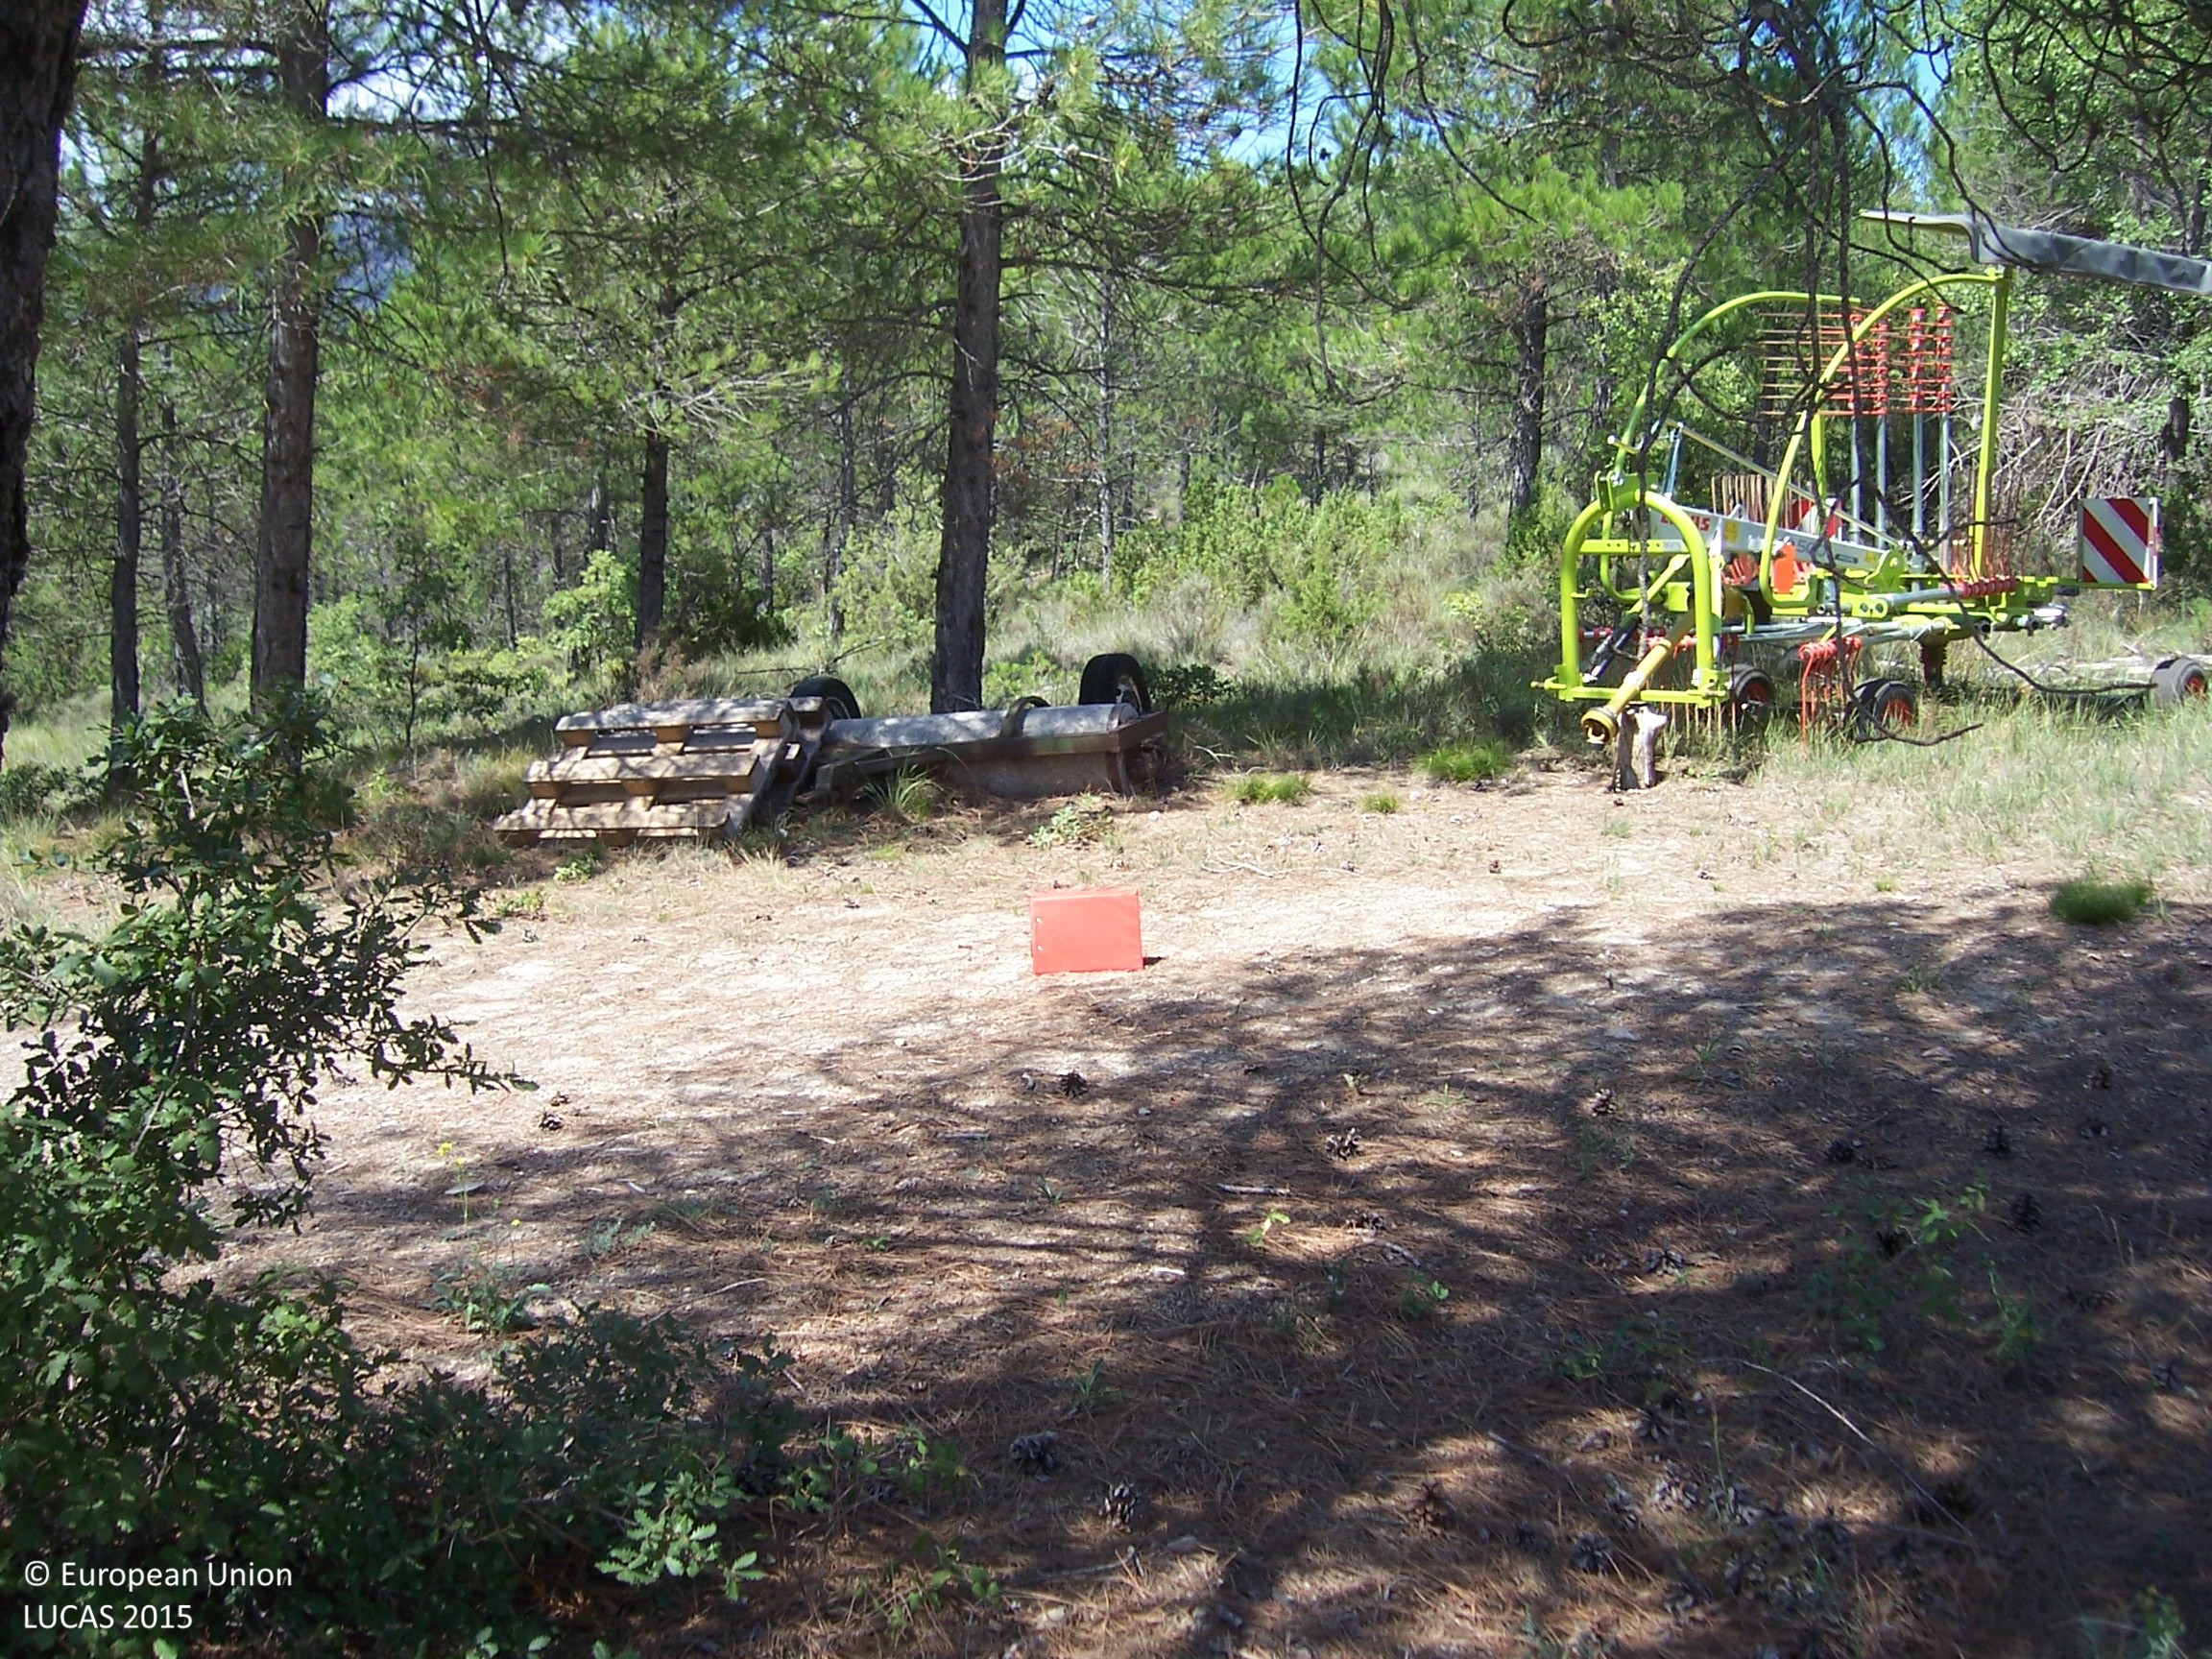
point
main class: Woodland
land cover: Pine dominated mixed woodland
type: coniferous forest of the mediterranean region
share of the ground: > 75 %
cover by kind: coniferous forest trees 30 %, herbaceous plants 30 %, unconsolidated bare surface 20 %, broadleaved forest trees 10 %, shrubs 10 %
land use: Semi-natural and natural areas not in use
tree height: > 5 m
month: August
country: ES
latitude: 42.3290
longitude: 0.2597
